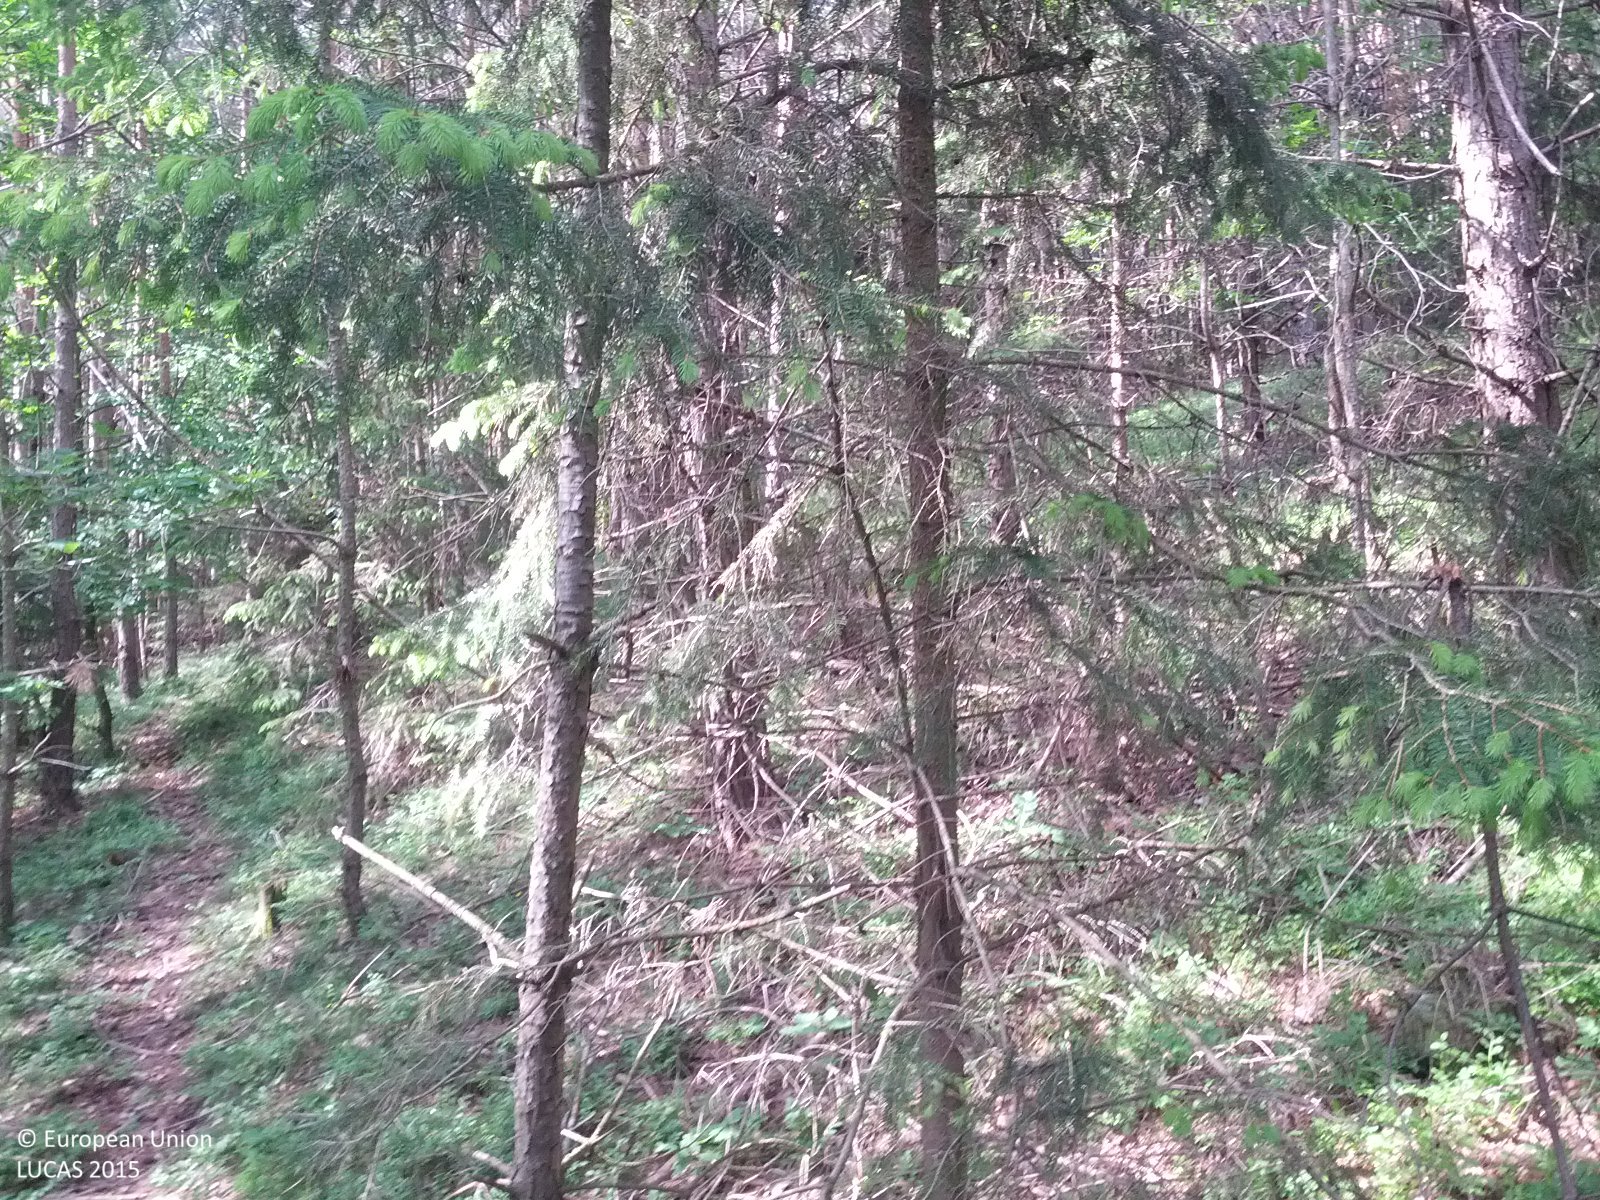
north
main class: Woodland
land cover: Pine dominated mixed woodland
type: boreal forest
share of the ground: > 75 %
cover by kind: coniferous forest trees 50 %, broadleaved forest trees 25 %, shrubs 20 %, herbaceous plants 5 %
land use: Forestry
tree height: > 5 m
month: May
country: AT
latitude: 47.4013
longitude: 16.1639
